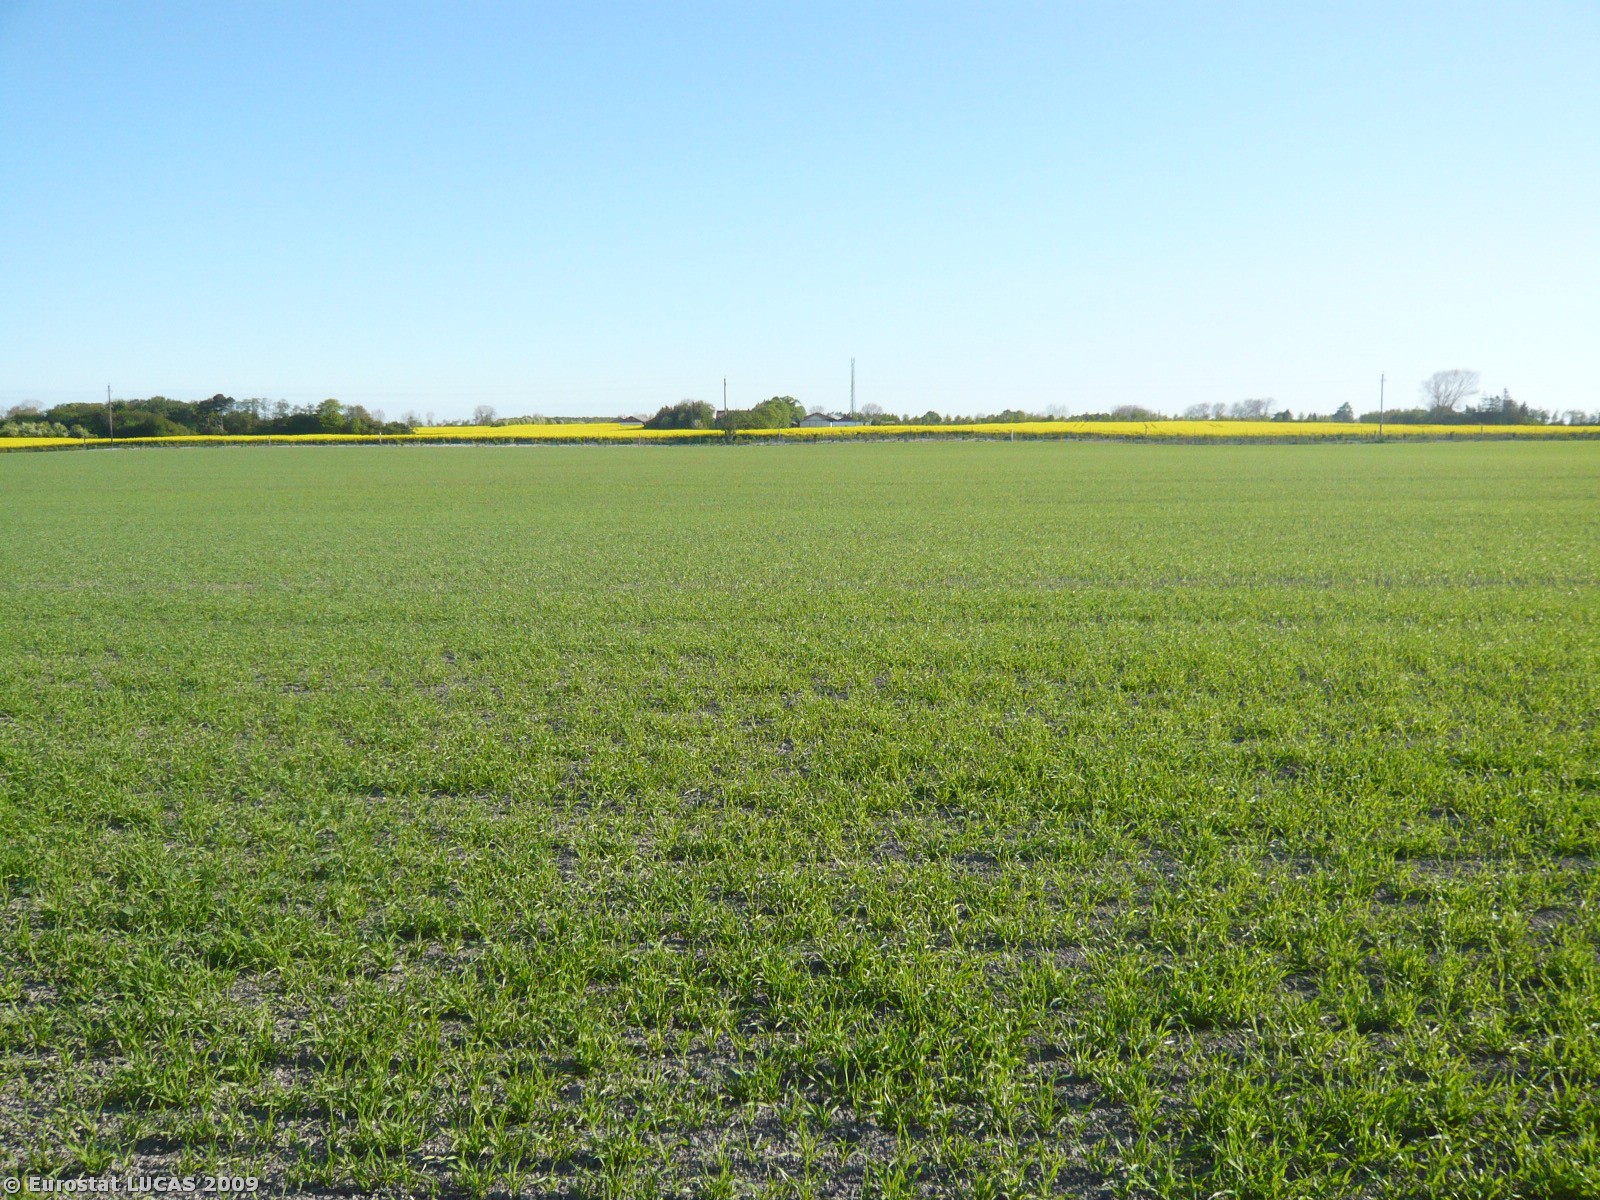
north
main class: Cropland
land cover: Common wheat
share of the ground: 25 - 50 %
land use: Agriculture (excluding fallow land and kitchen gardens)
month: May
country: DK
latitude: 55.0910
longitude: 12.1451
